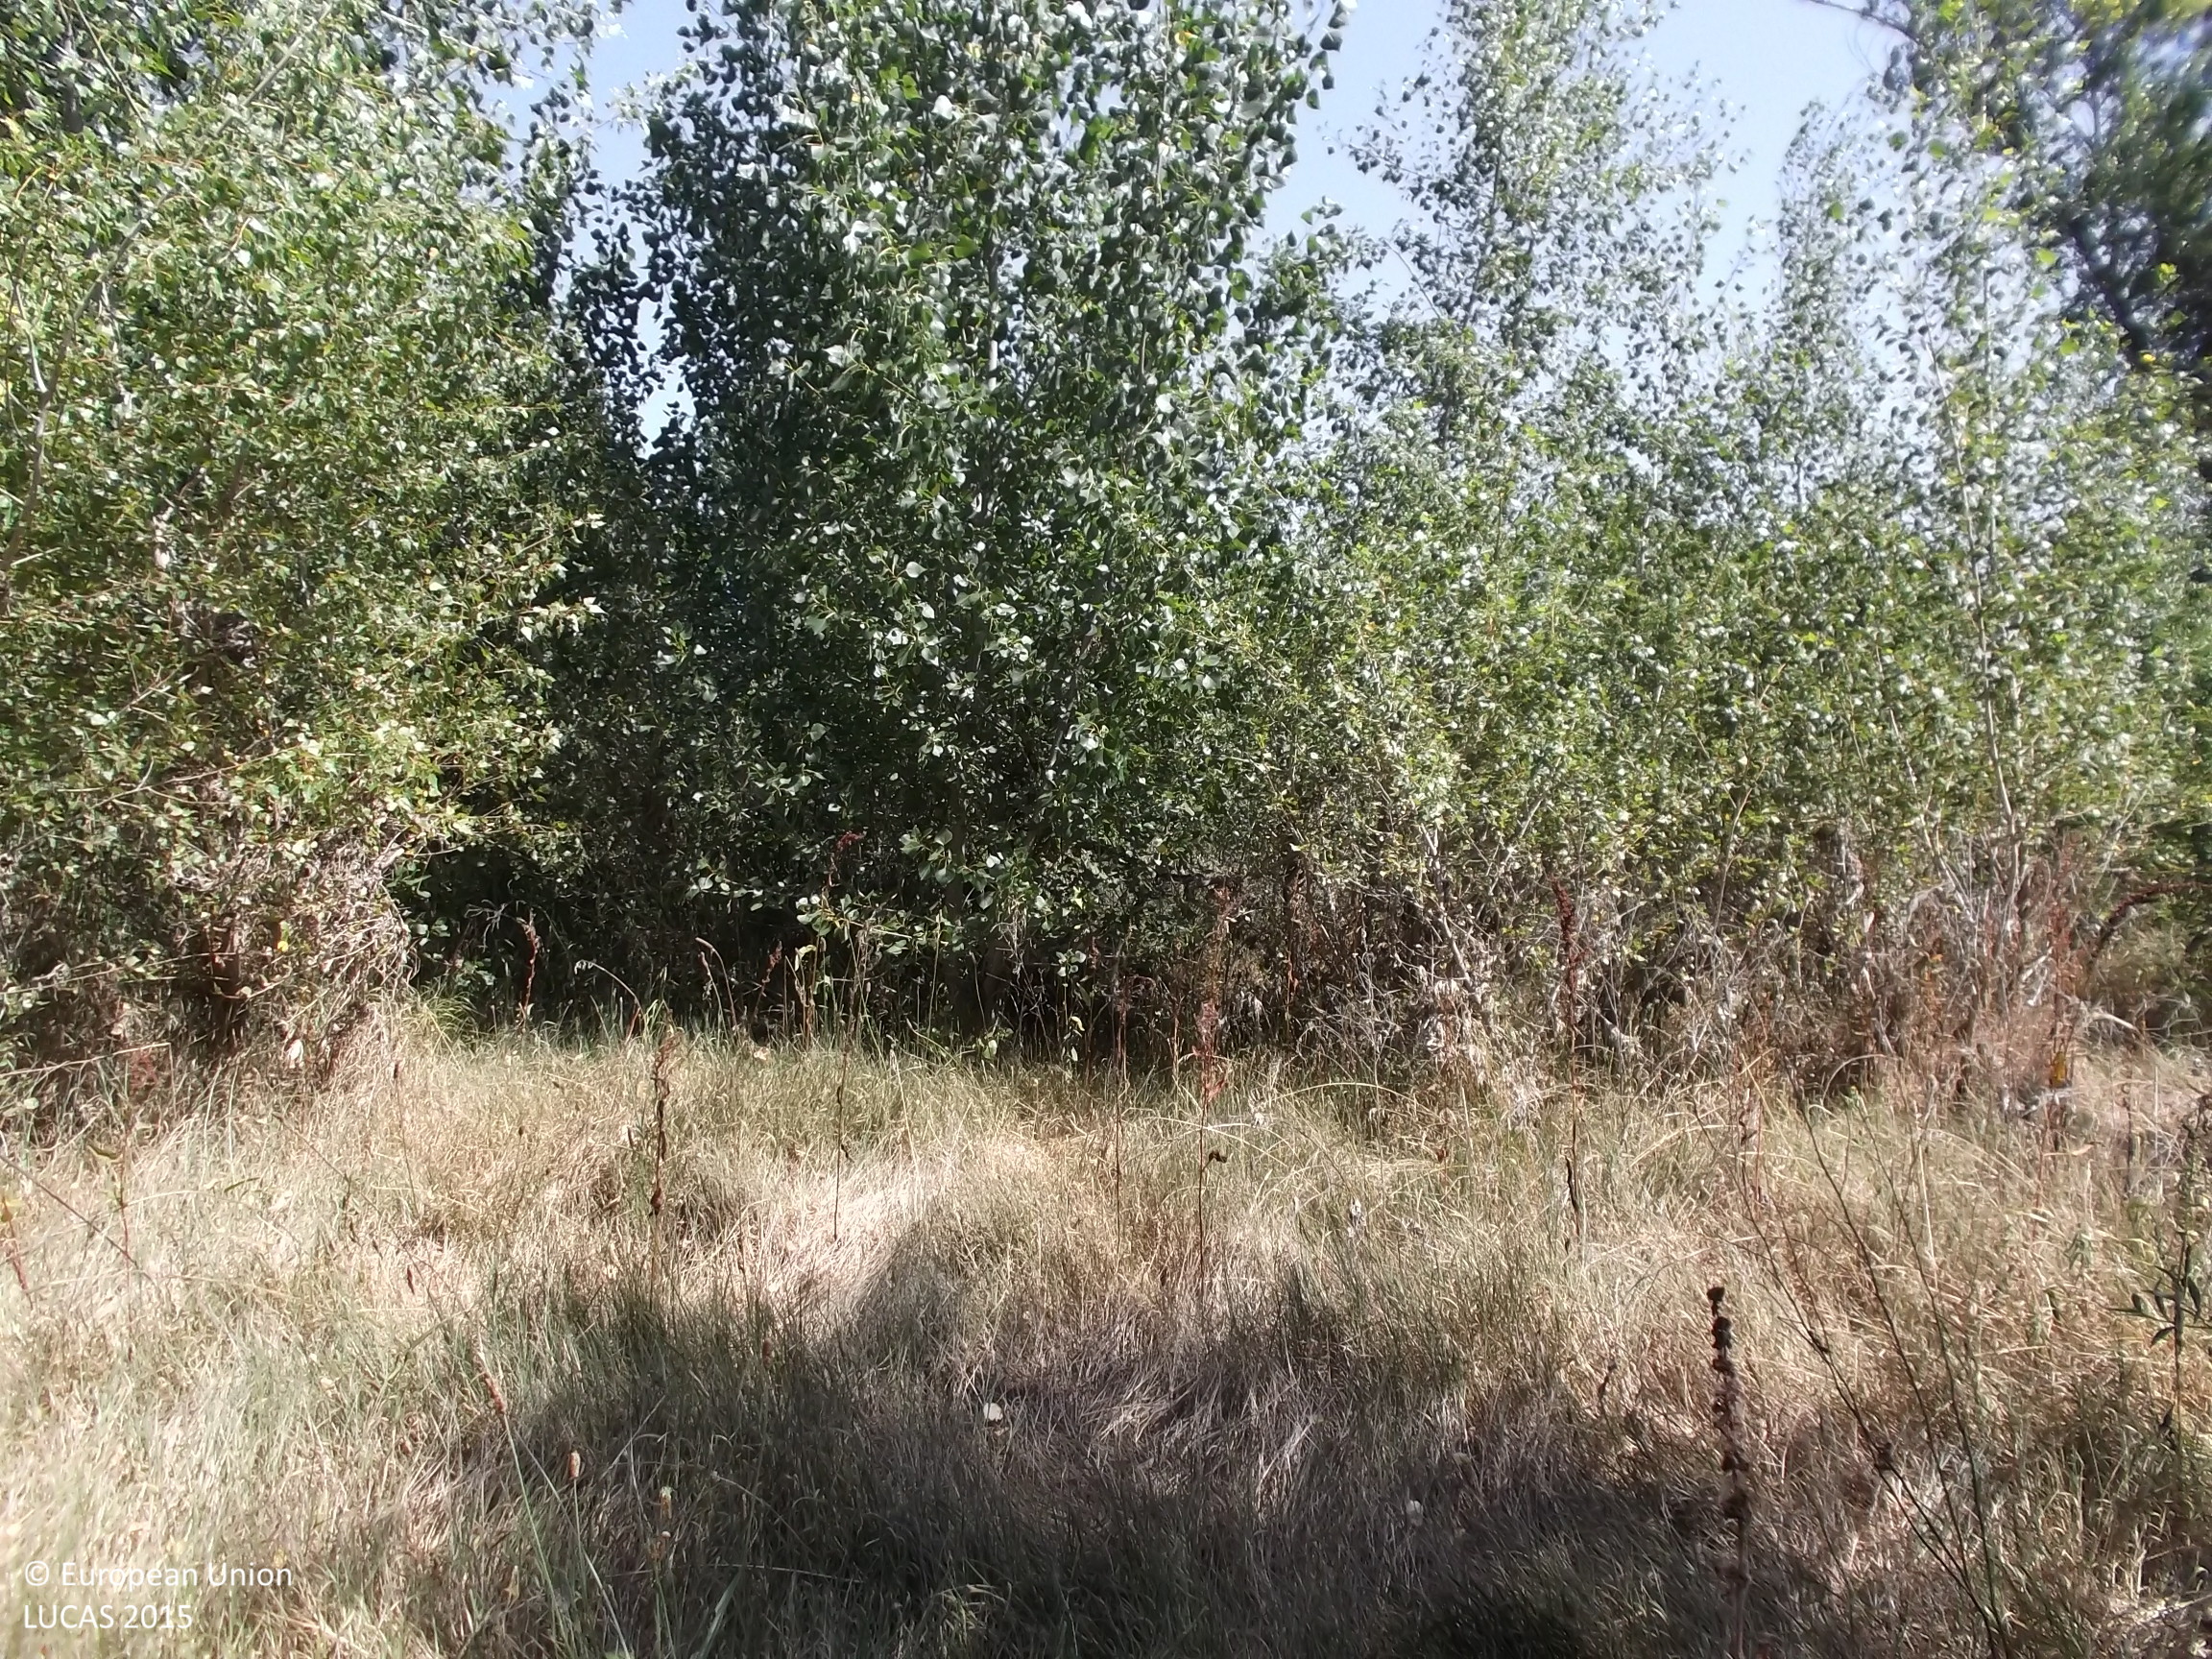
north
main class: Woodland
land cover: Broadleaved woodland
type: floodplain forest
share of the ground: > 75 %
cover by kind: broadleaved forest trees 80 %, herbaceous plants 20 %
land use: Semi-natural and natural areas not in use
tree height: > 5 m
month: July
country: ES
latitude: 42.3437
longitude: -1.6513
